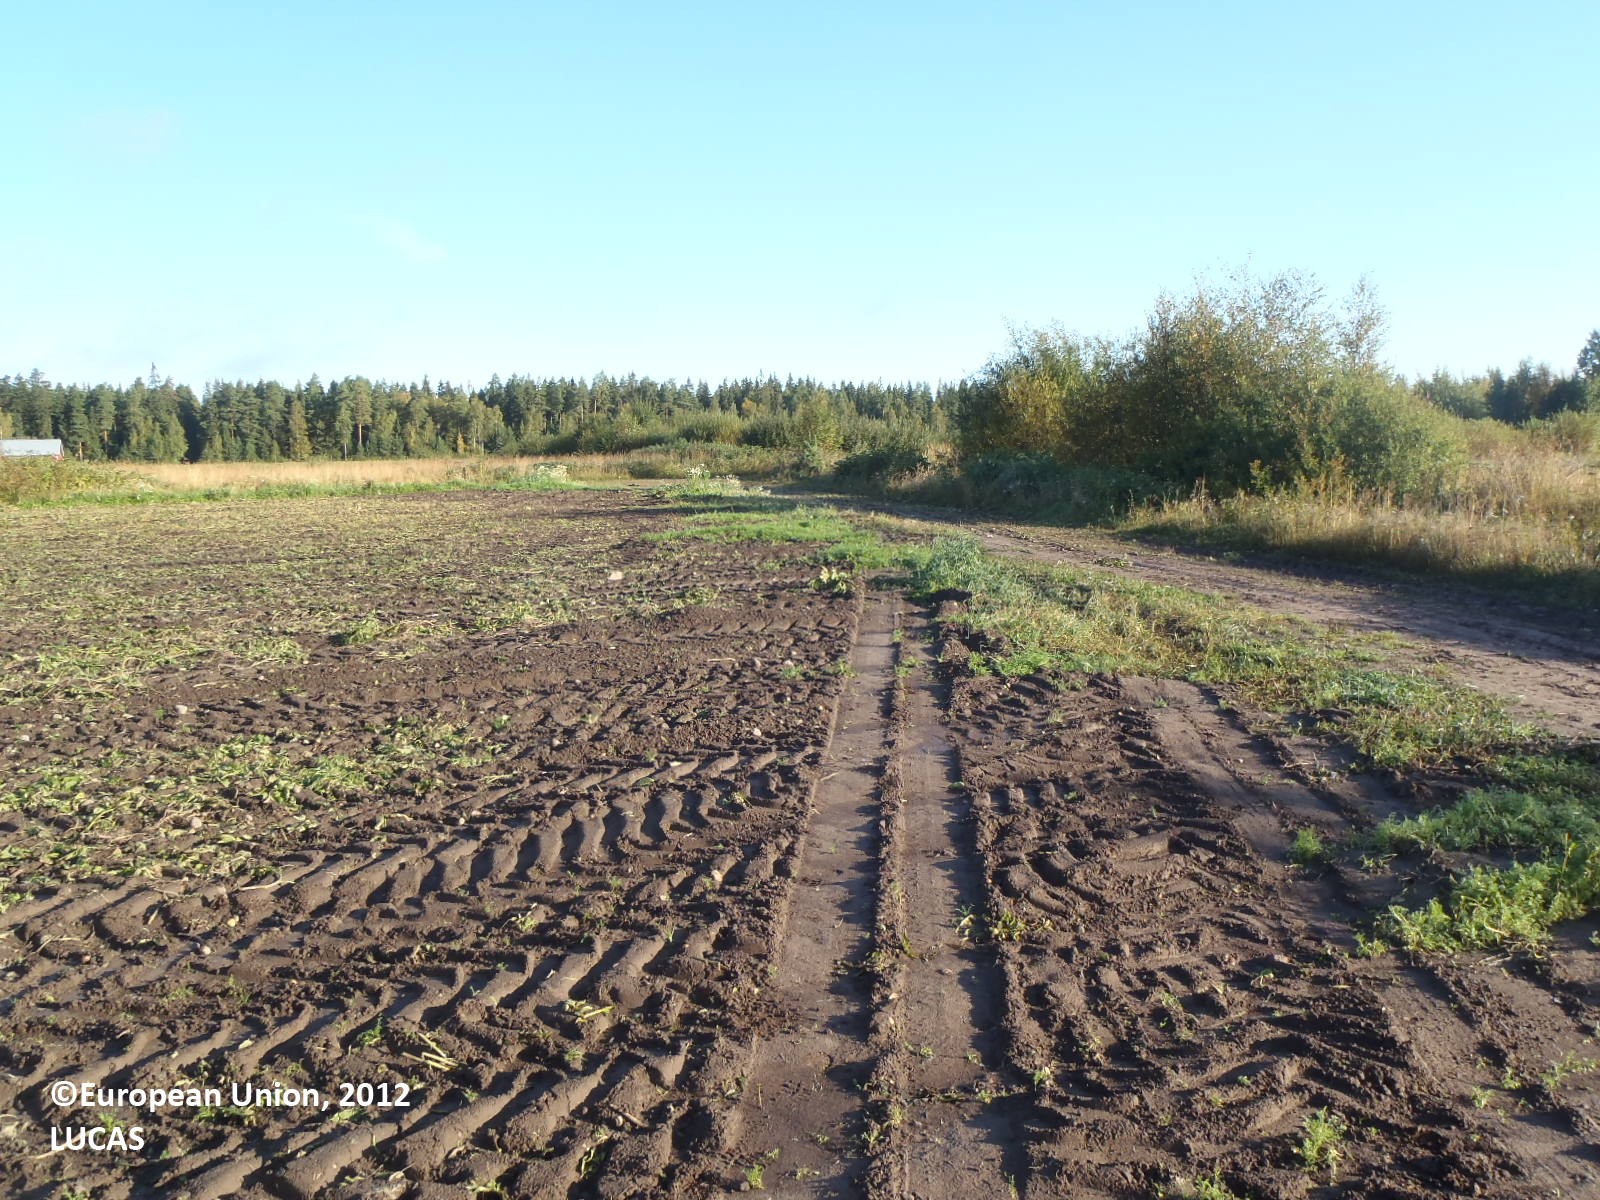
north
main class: Cropland
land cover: Potatoes
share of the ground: 50 - 75 %
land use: Agriculture (excluding fallow land and kitchen gardens)
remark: Harvested field
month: September
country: FI
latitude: 61.0537
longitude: 22.4197
